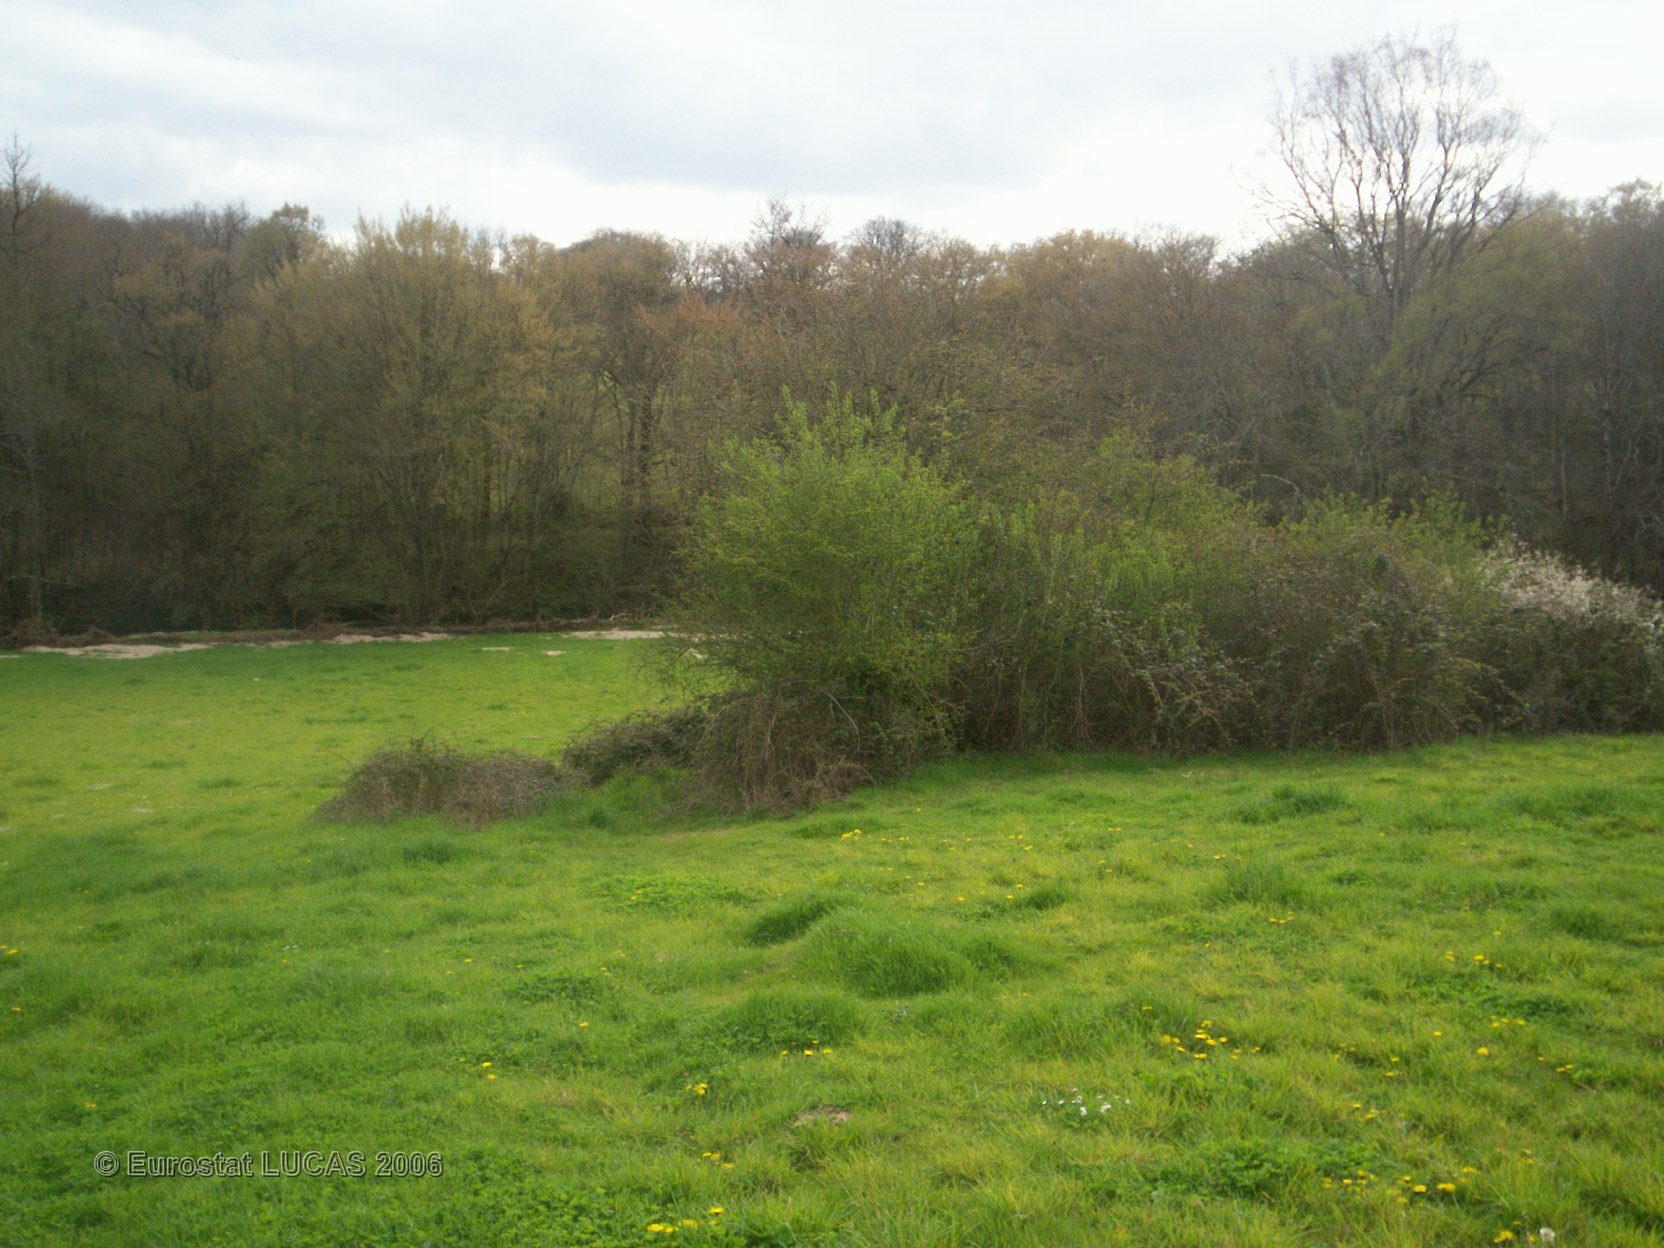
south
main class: Grassland
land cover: Grassland without tree/shrub cover
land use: Agriculture (excluding fallow land and kitchen gardens)
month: April
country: FR
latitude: 46.4302
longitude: 1.0728
